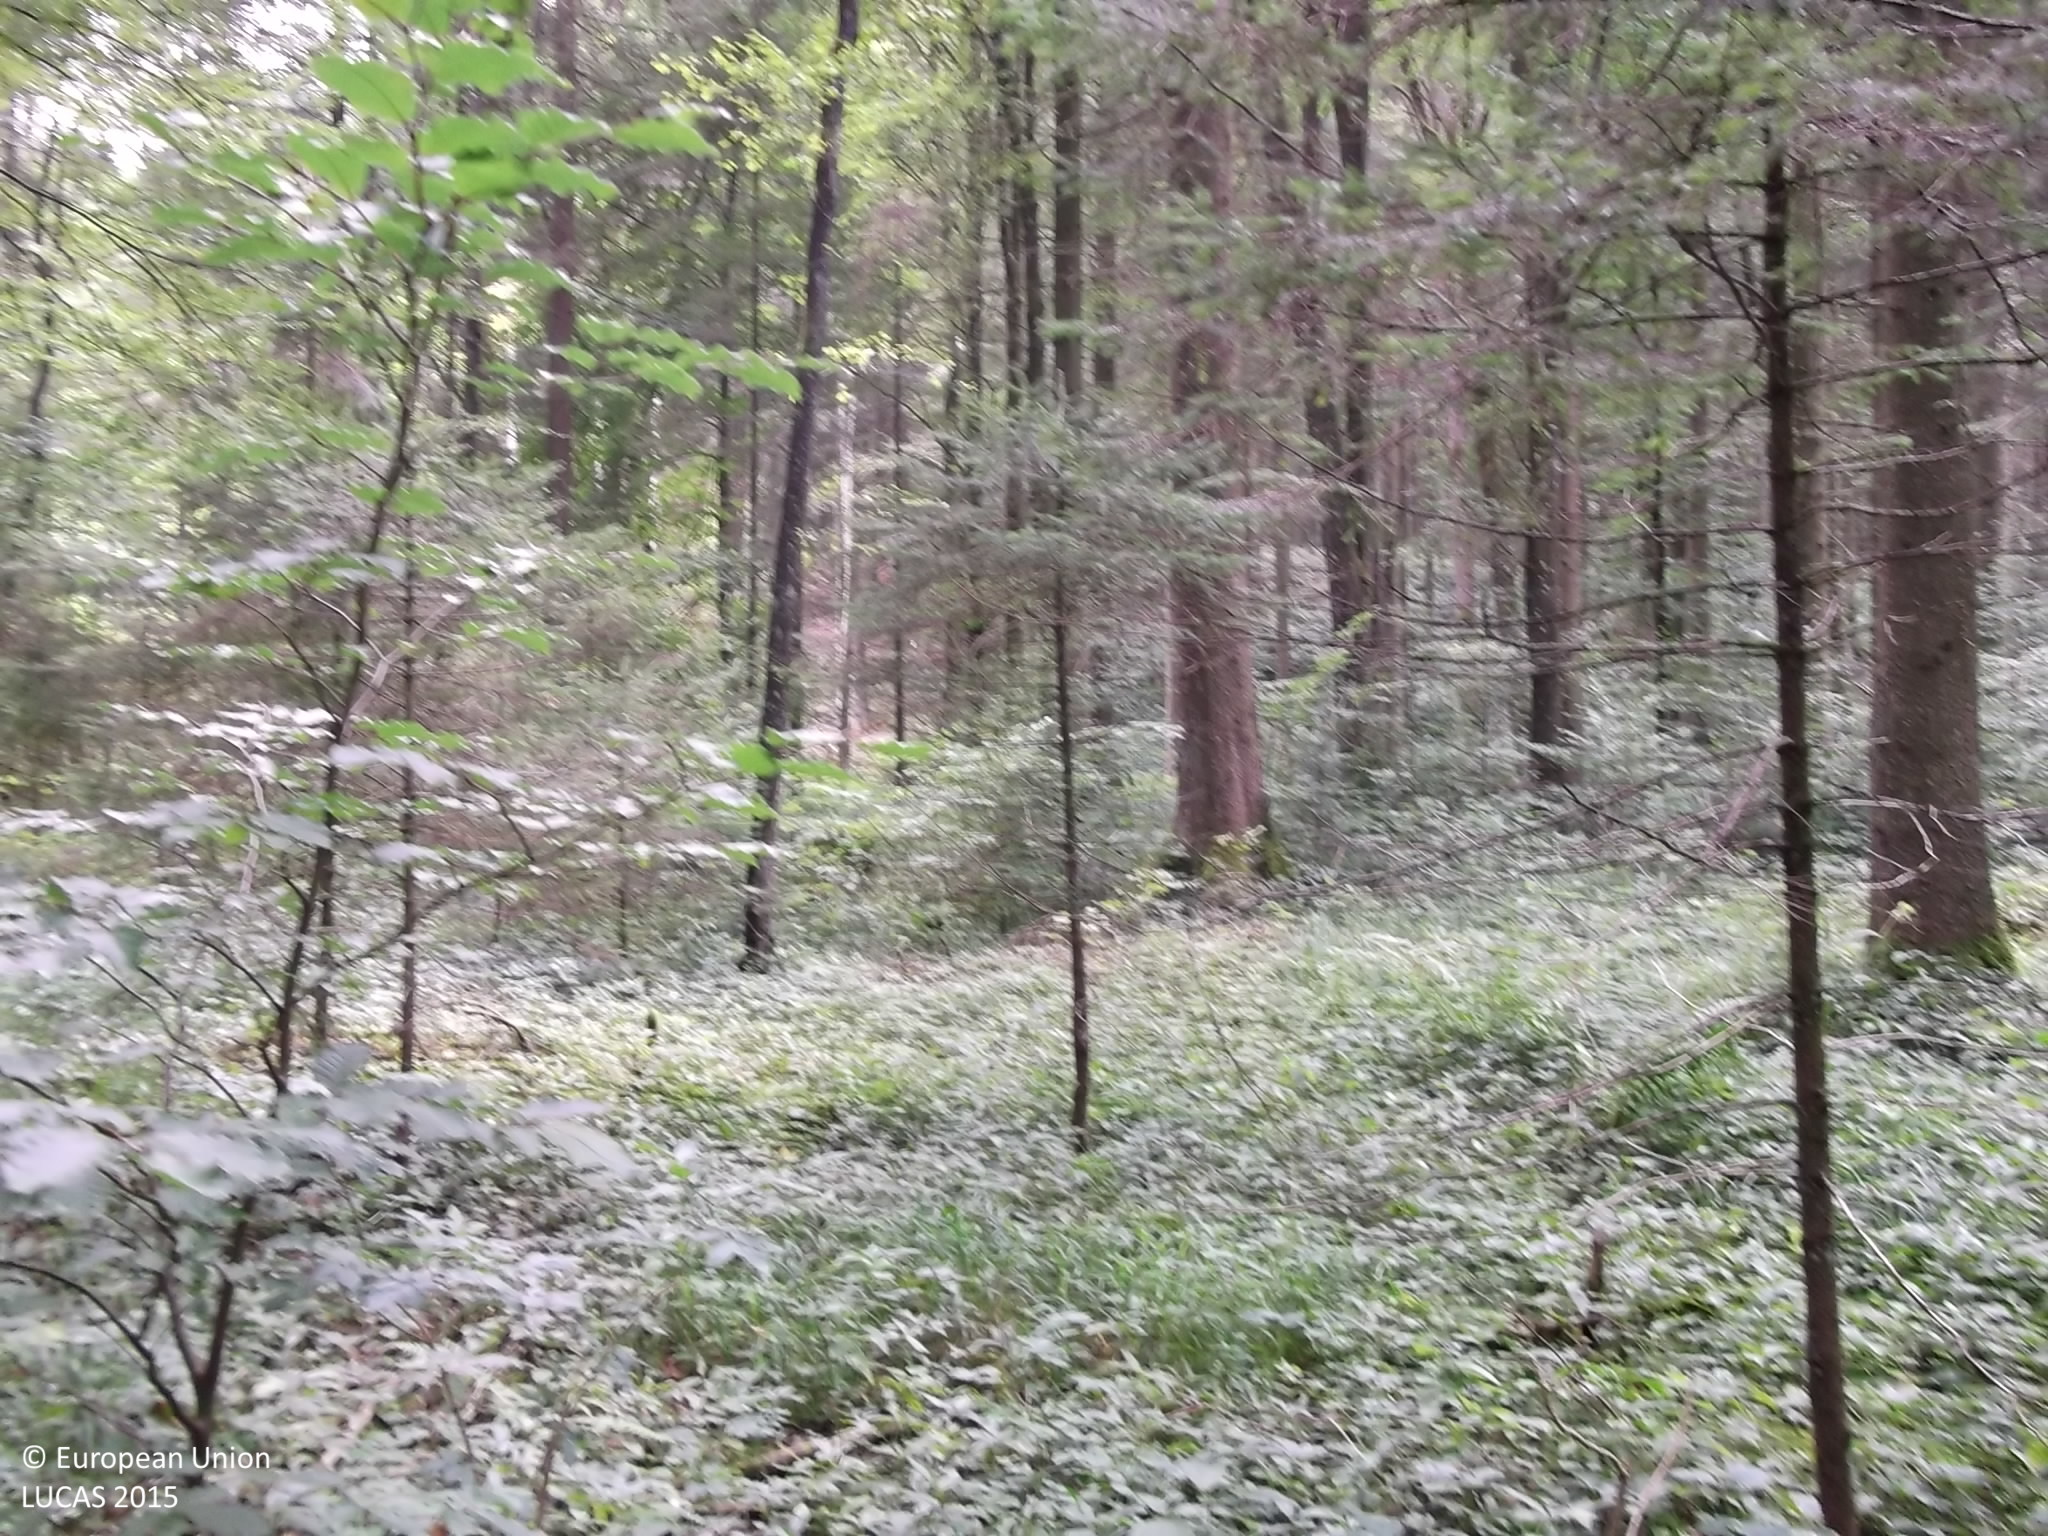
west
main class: Woodland
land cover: Spruce dominated mixed woodland
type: hemiboreal forest and nemoral coniferous forest and mixed broadleaved-coniferous forest
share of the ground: > 75 %
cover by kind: coniferous forest trees 45 %, broadleaved forest trees 40 %, herbaceous plants 15 %
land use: Forestry
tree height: > 5 m
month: August
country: AT
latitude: 47.9383
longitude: 13.3589
